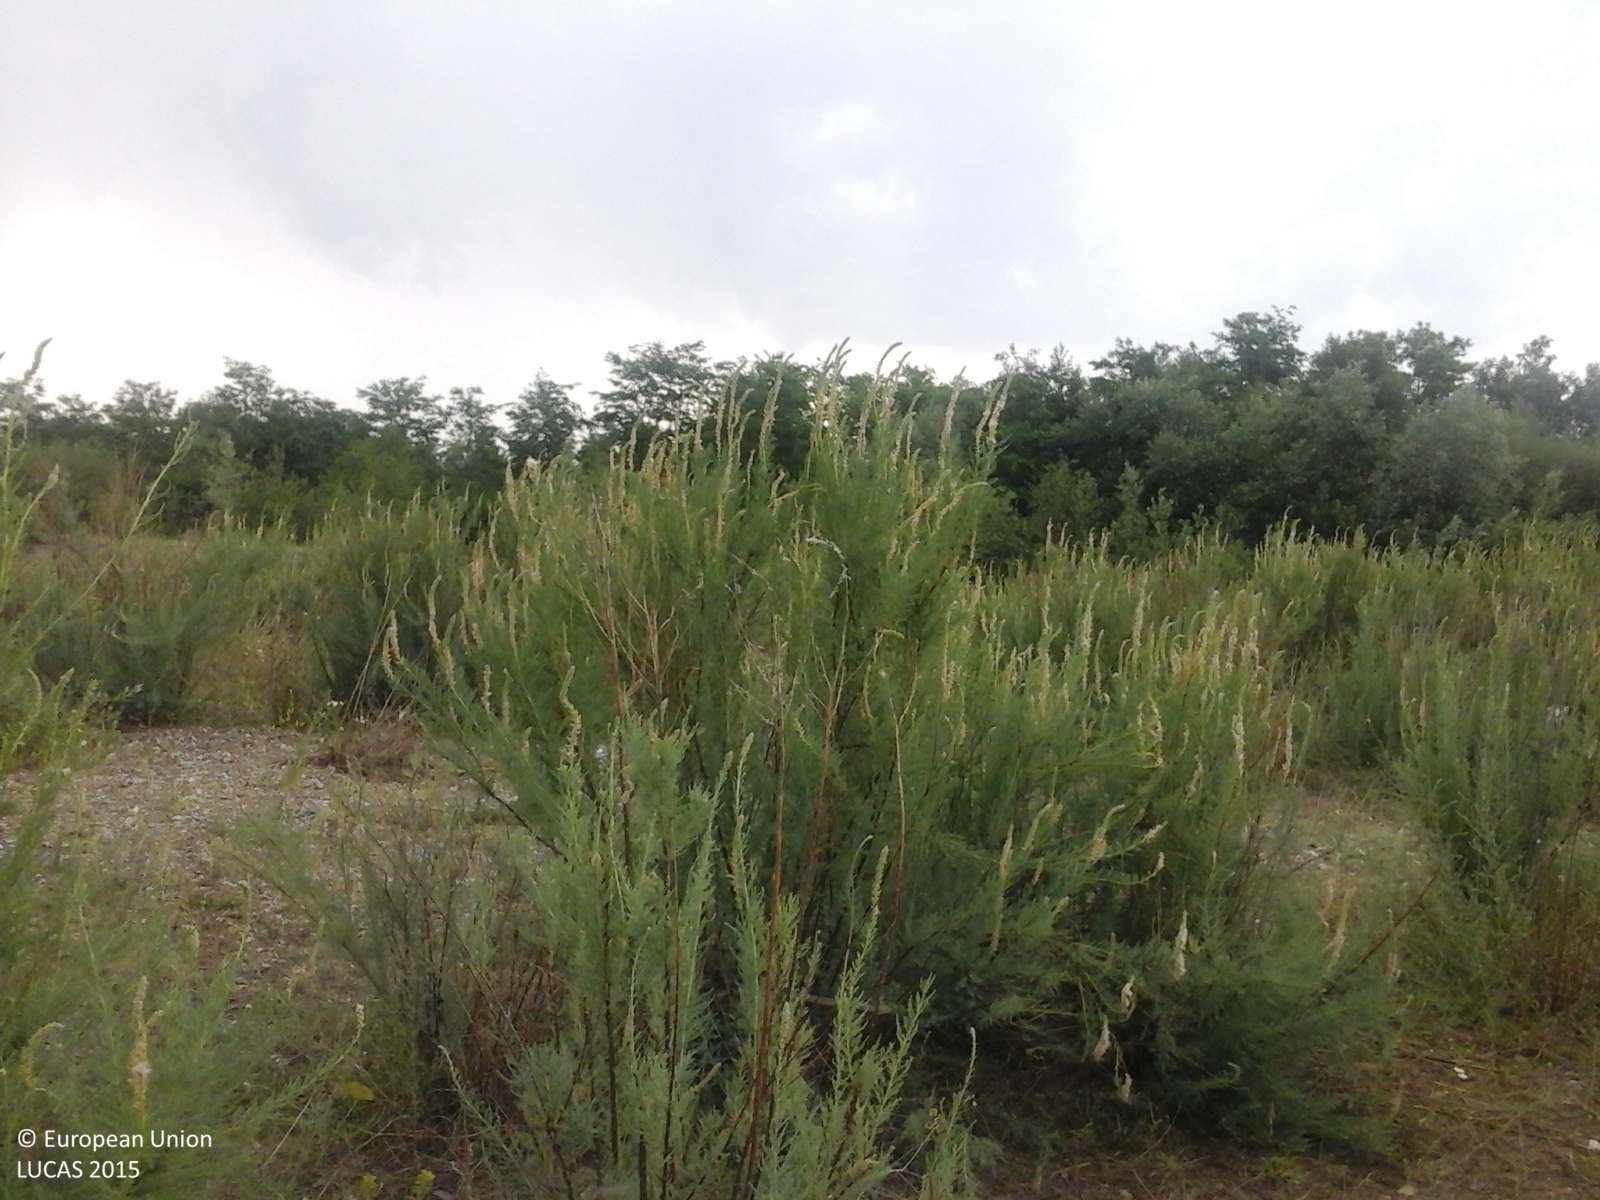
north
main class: Grassland
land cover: Spontaneously vegetated surfaces
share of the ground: 25 - 50 %
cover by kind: unconsolidated bare surface 50 %, herbaceous plants 45 %, shrubs 5 %
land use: Semi-natural and natural areas not in use
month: June
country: RO
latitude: 47.3033
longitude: 26.4739
